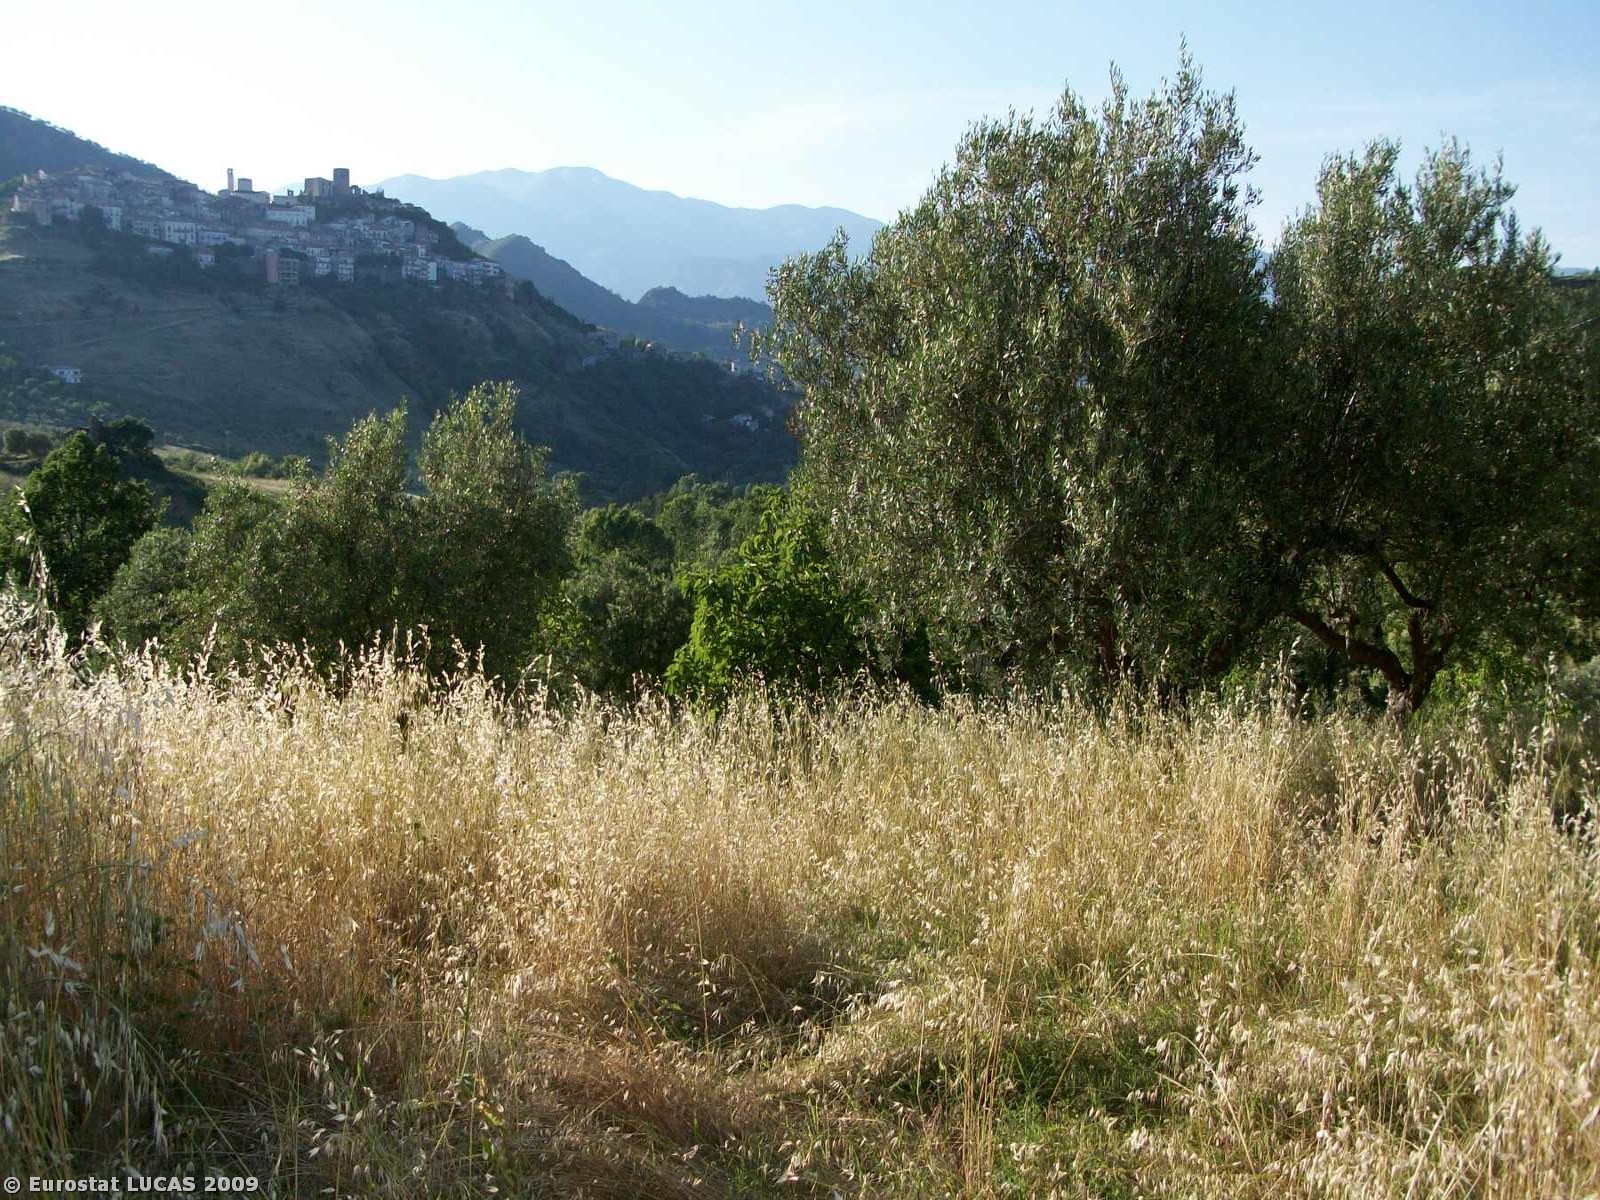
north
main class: Grassland
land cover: Grassland with sparse tree/shrub cover
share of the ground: > 75 %
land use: Fallow land
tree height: < 5 m
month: June
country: IT
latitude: 39.5897
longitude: 16.0613
